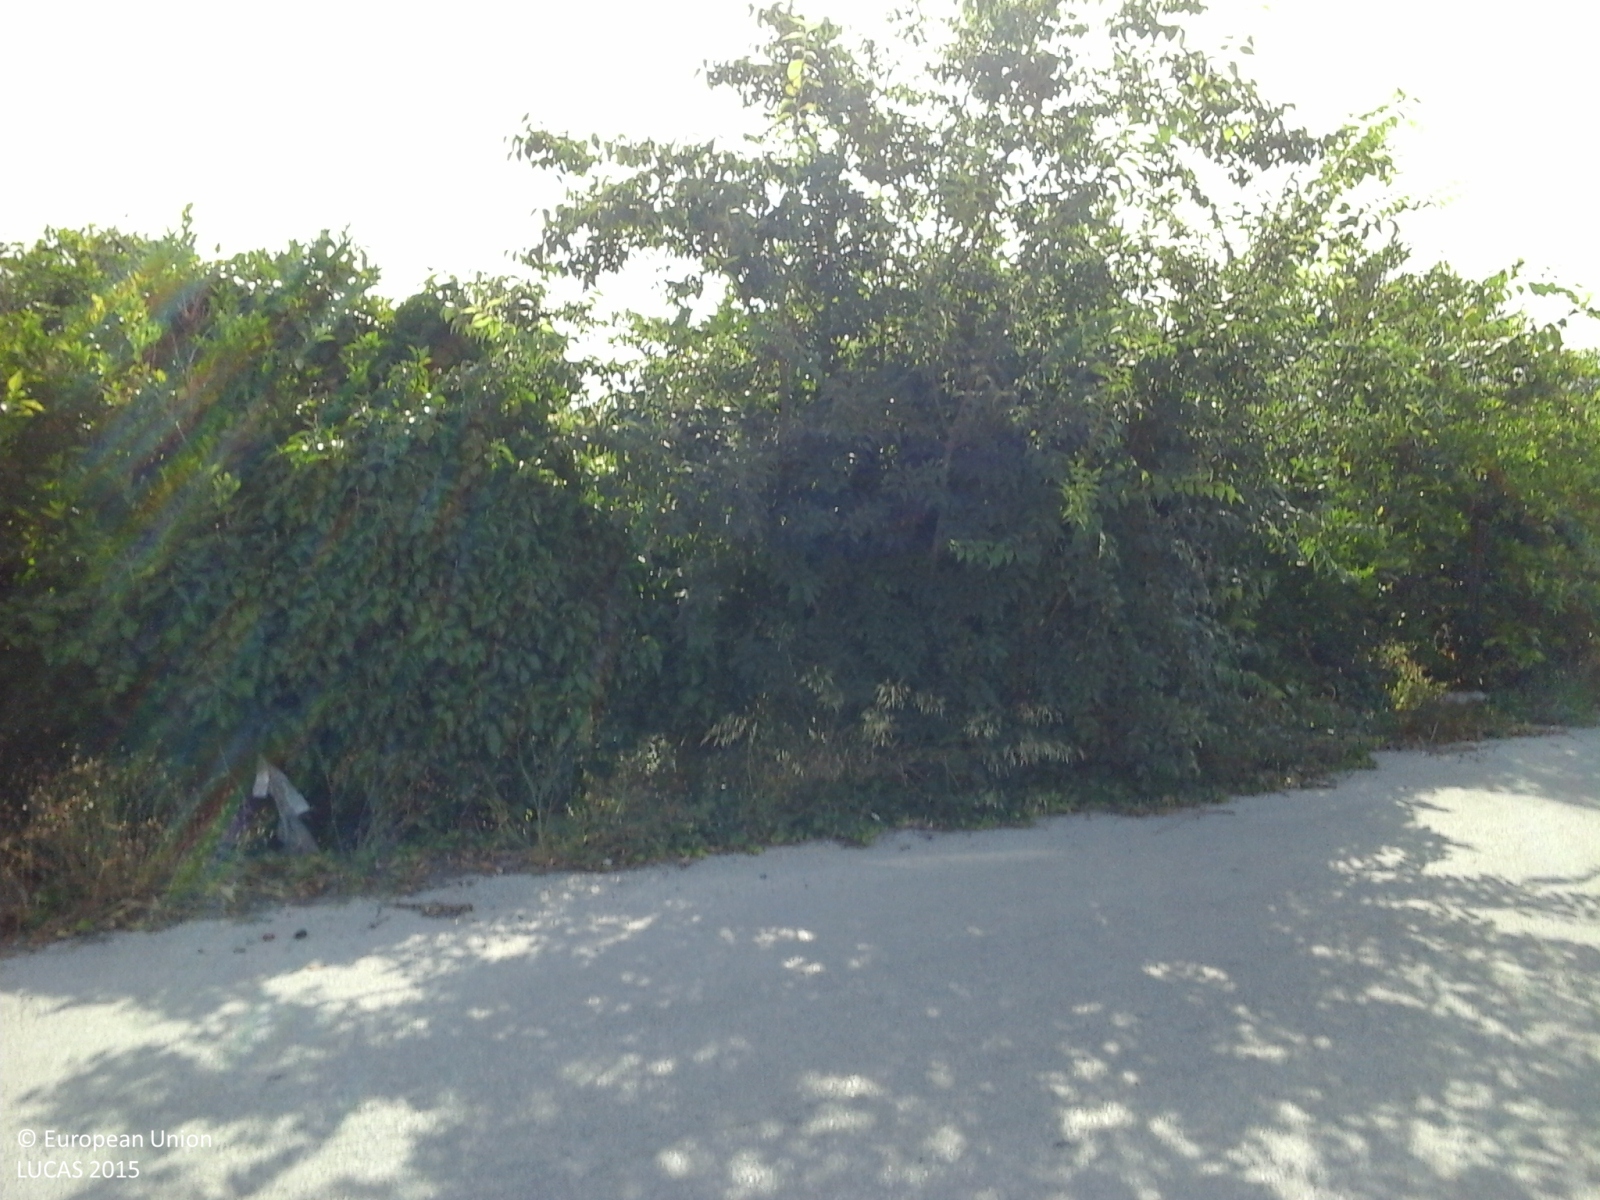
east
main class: Cropland
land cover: Oranges
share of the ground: > 75 %
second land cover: Spontaneously vegetated surfaces
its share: > 75 %
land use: Agriculture (excluding fallow land and kitchen gardens)
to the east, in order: Oranges; Spontaneously vegetated surfaces; Oranges; Artificial constructions in urban areas
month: August
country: IT
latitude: 37.2217
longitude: 14.8880
